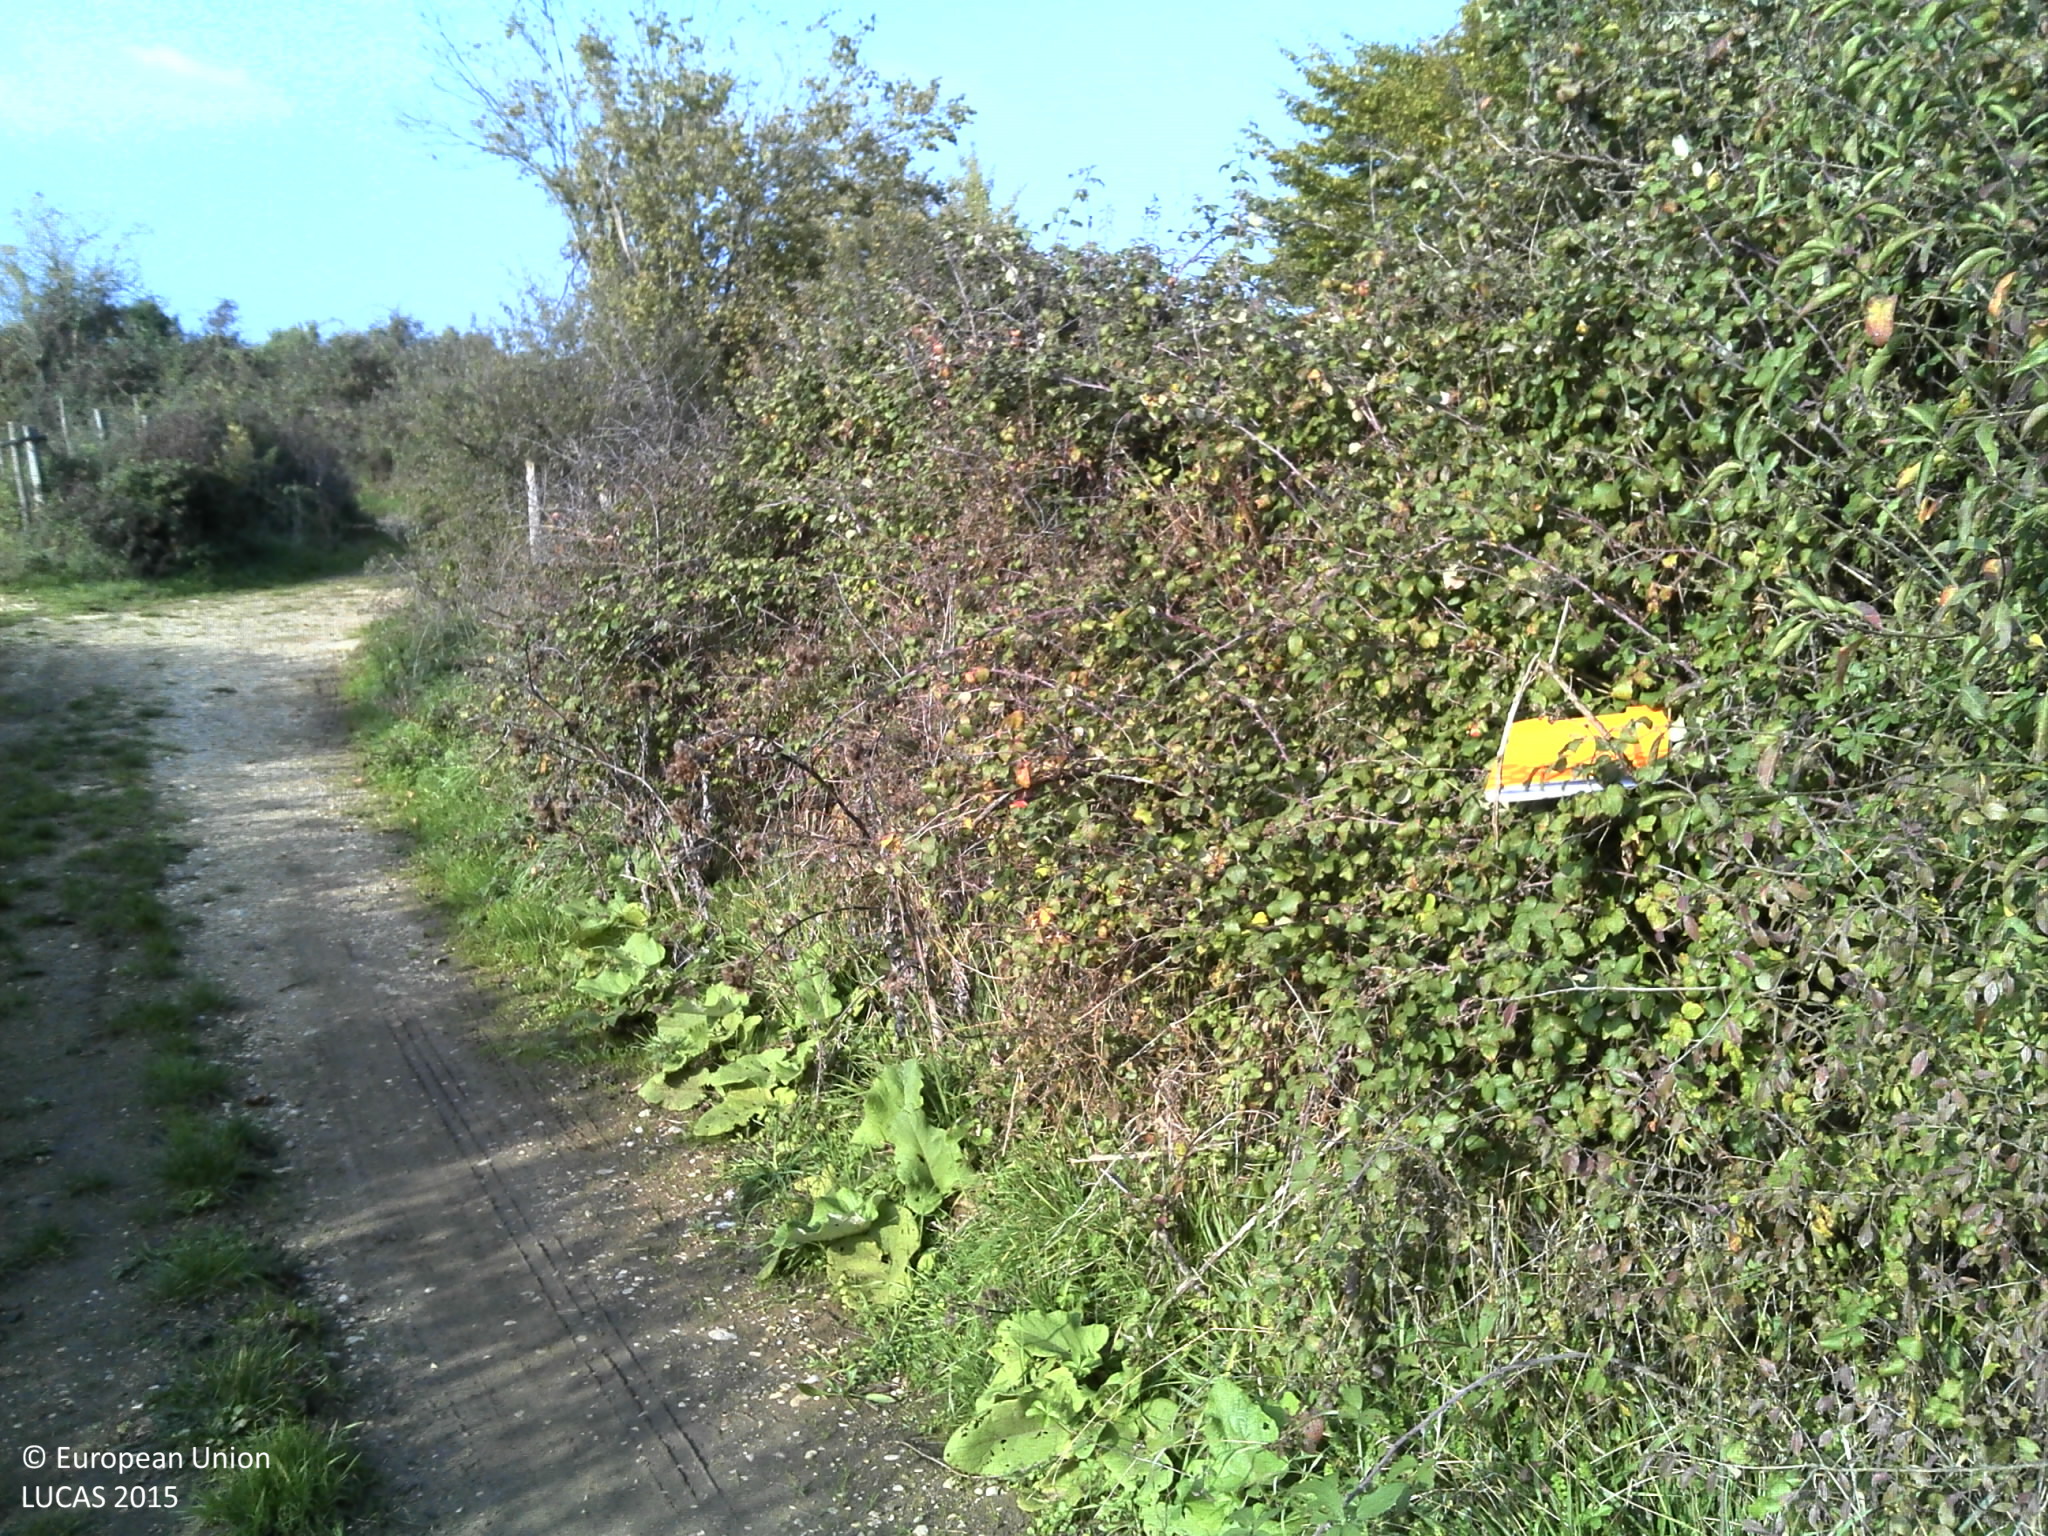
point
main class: Grassland
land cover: Grassland without tree/shrub cover
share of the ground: > 75 %
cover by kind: herbaceous plants 100 %
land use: Agriculture (excluding fallow land and kitchen gardens)
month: October
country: FR
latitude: 46.1433
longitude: 5.3816
